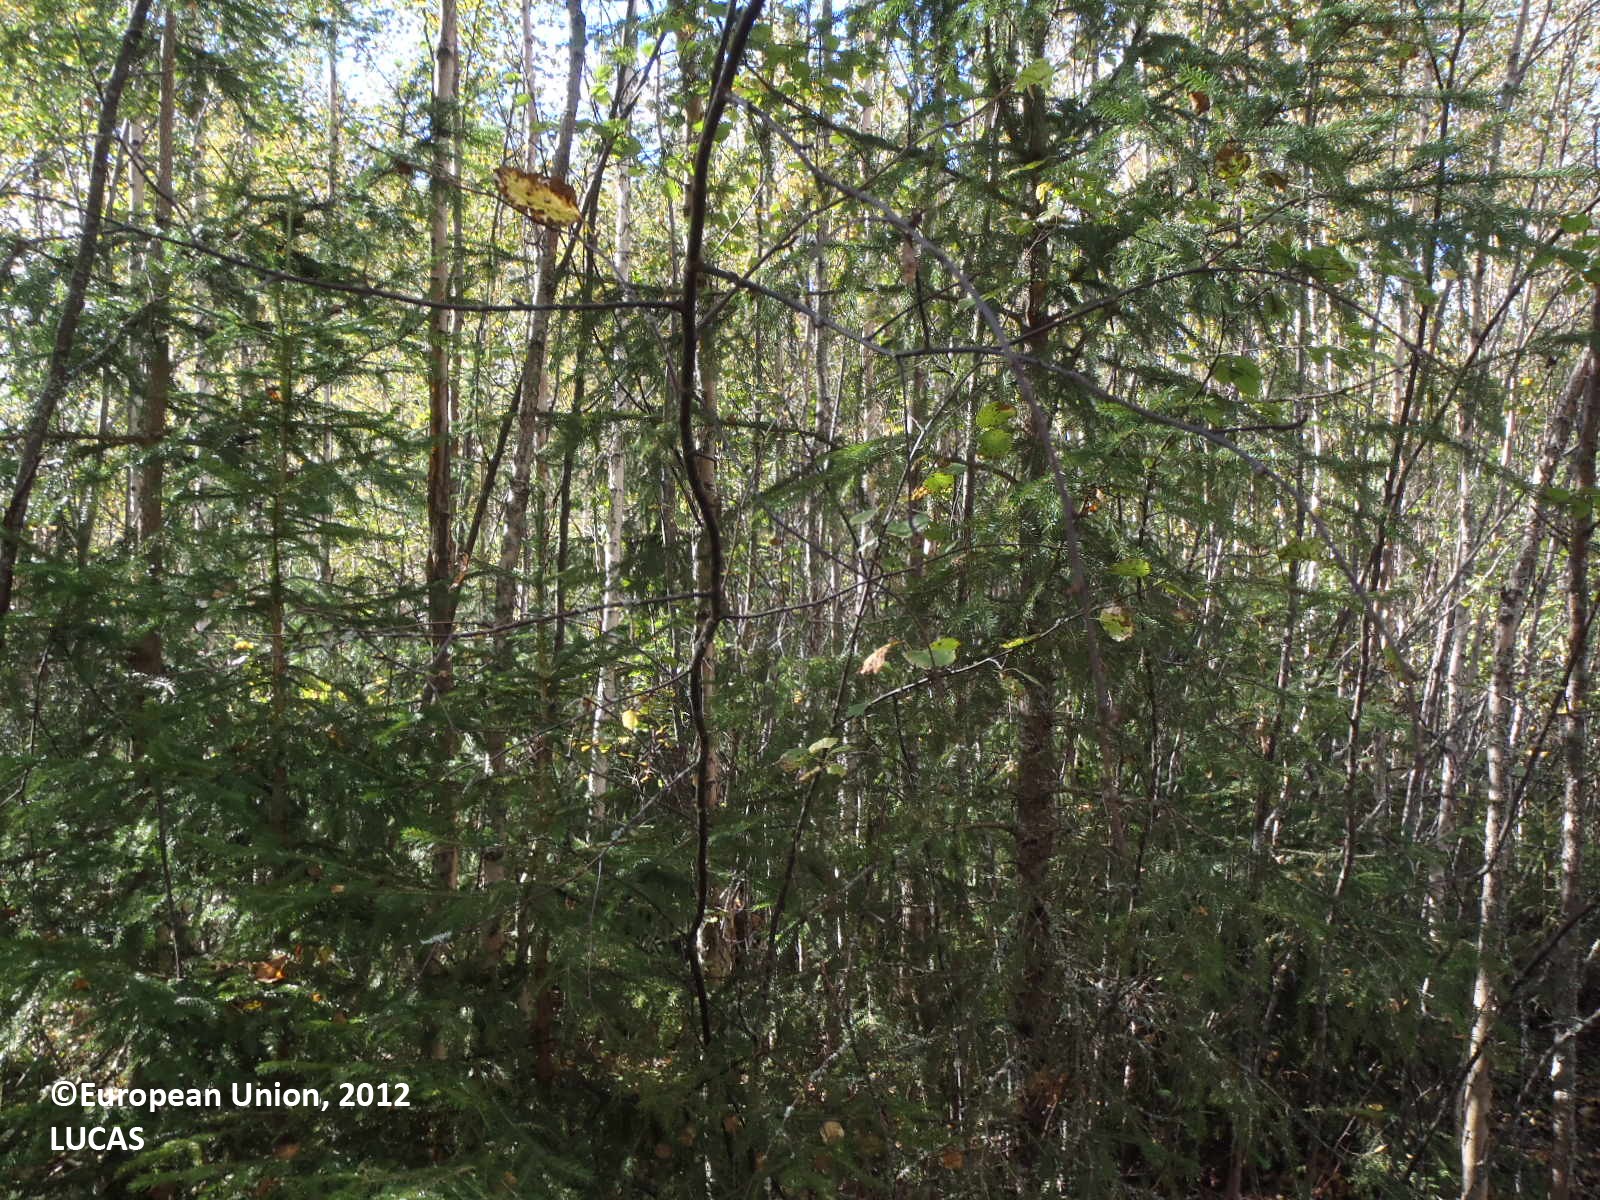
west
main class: Woodland
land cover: Broadleaved woodland
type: boreal forest
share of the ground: > 75 %
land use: Forestry
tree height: > 5 m
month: September
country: FI
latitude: 61.5166
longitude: 22.5641
